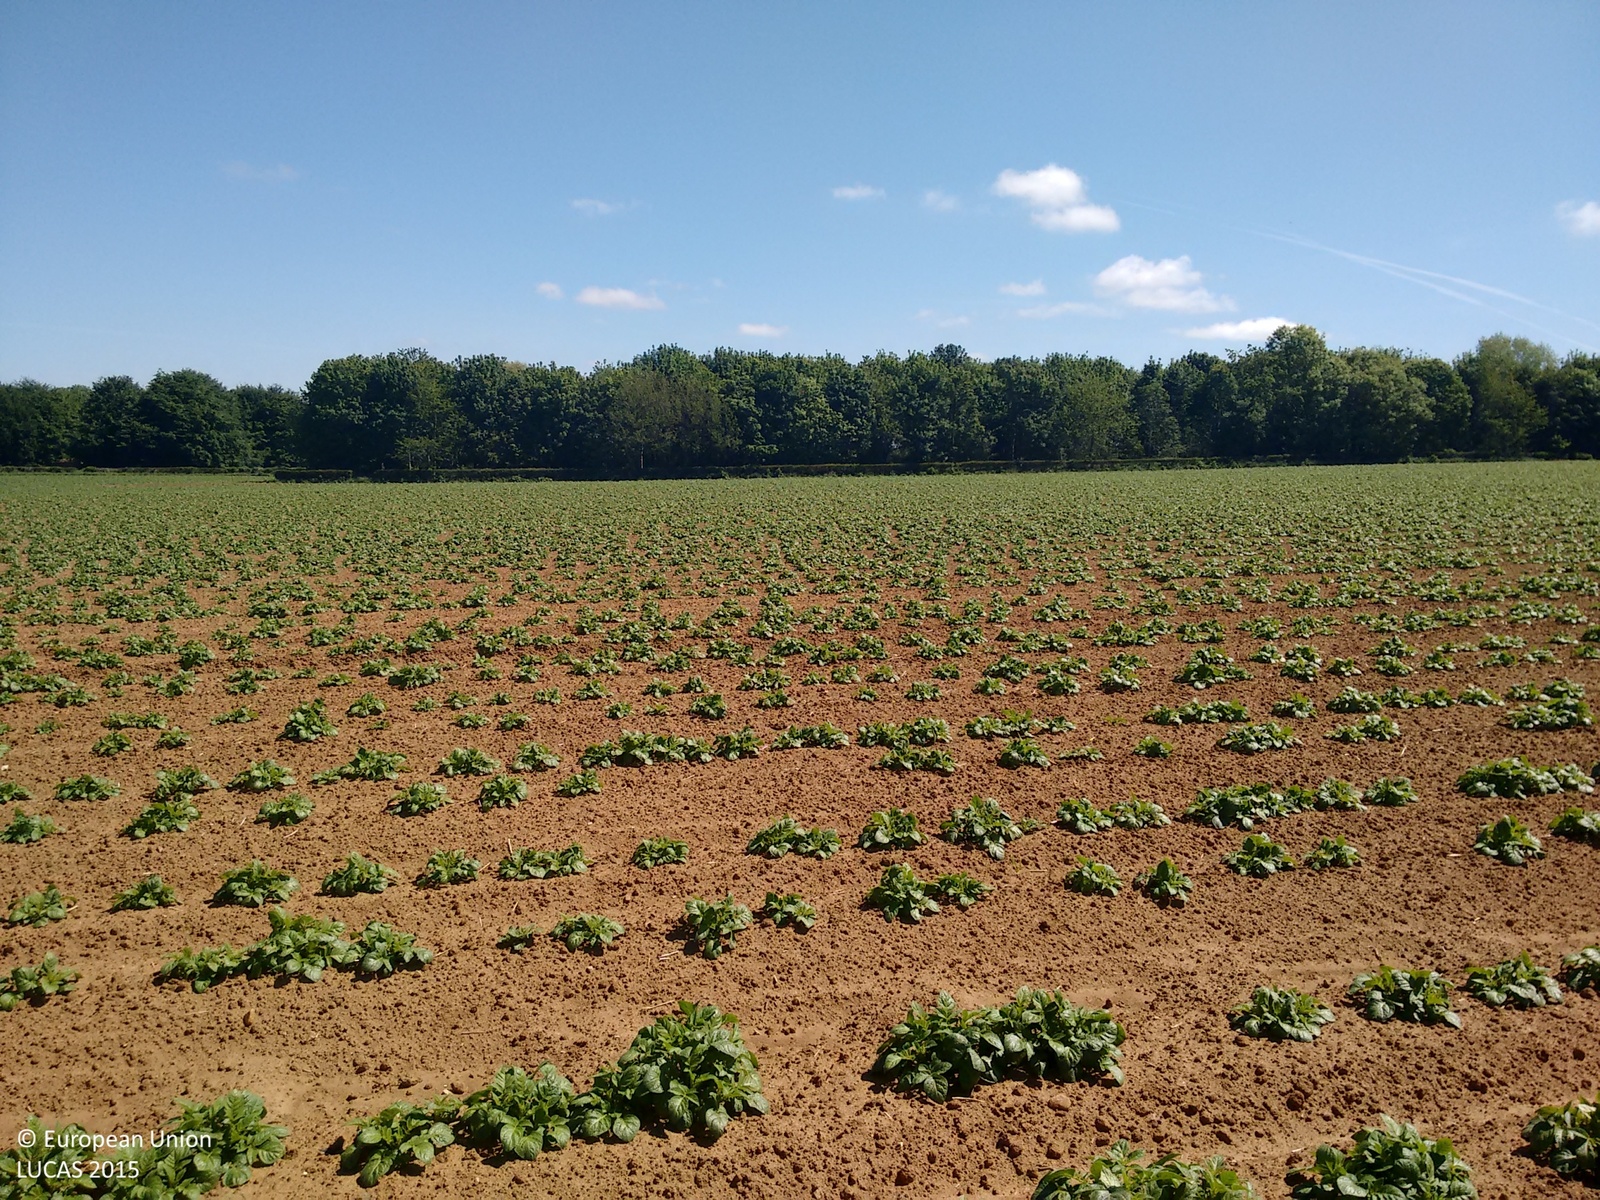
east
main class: Cropland
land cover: Potatoes
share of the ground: 10 - 25 %
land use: Agriculture (excluding fallow land and kitchen gardens)
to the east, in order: Potatoes; Managed hedges; Other mixed woodland; Single bushes/trees
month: June
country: GB
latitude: 54.1048
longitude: -0.9155
